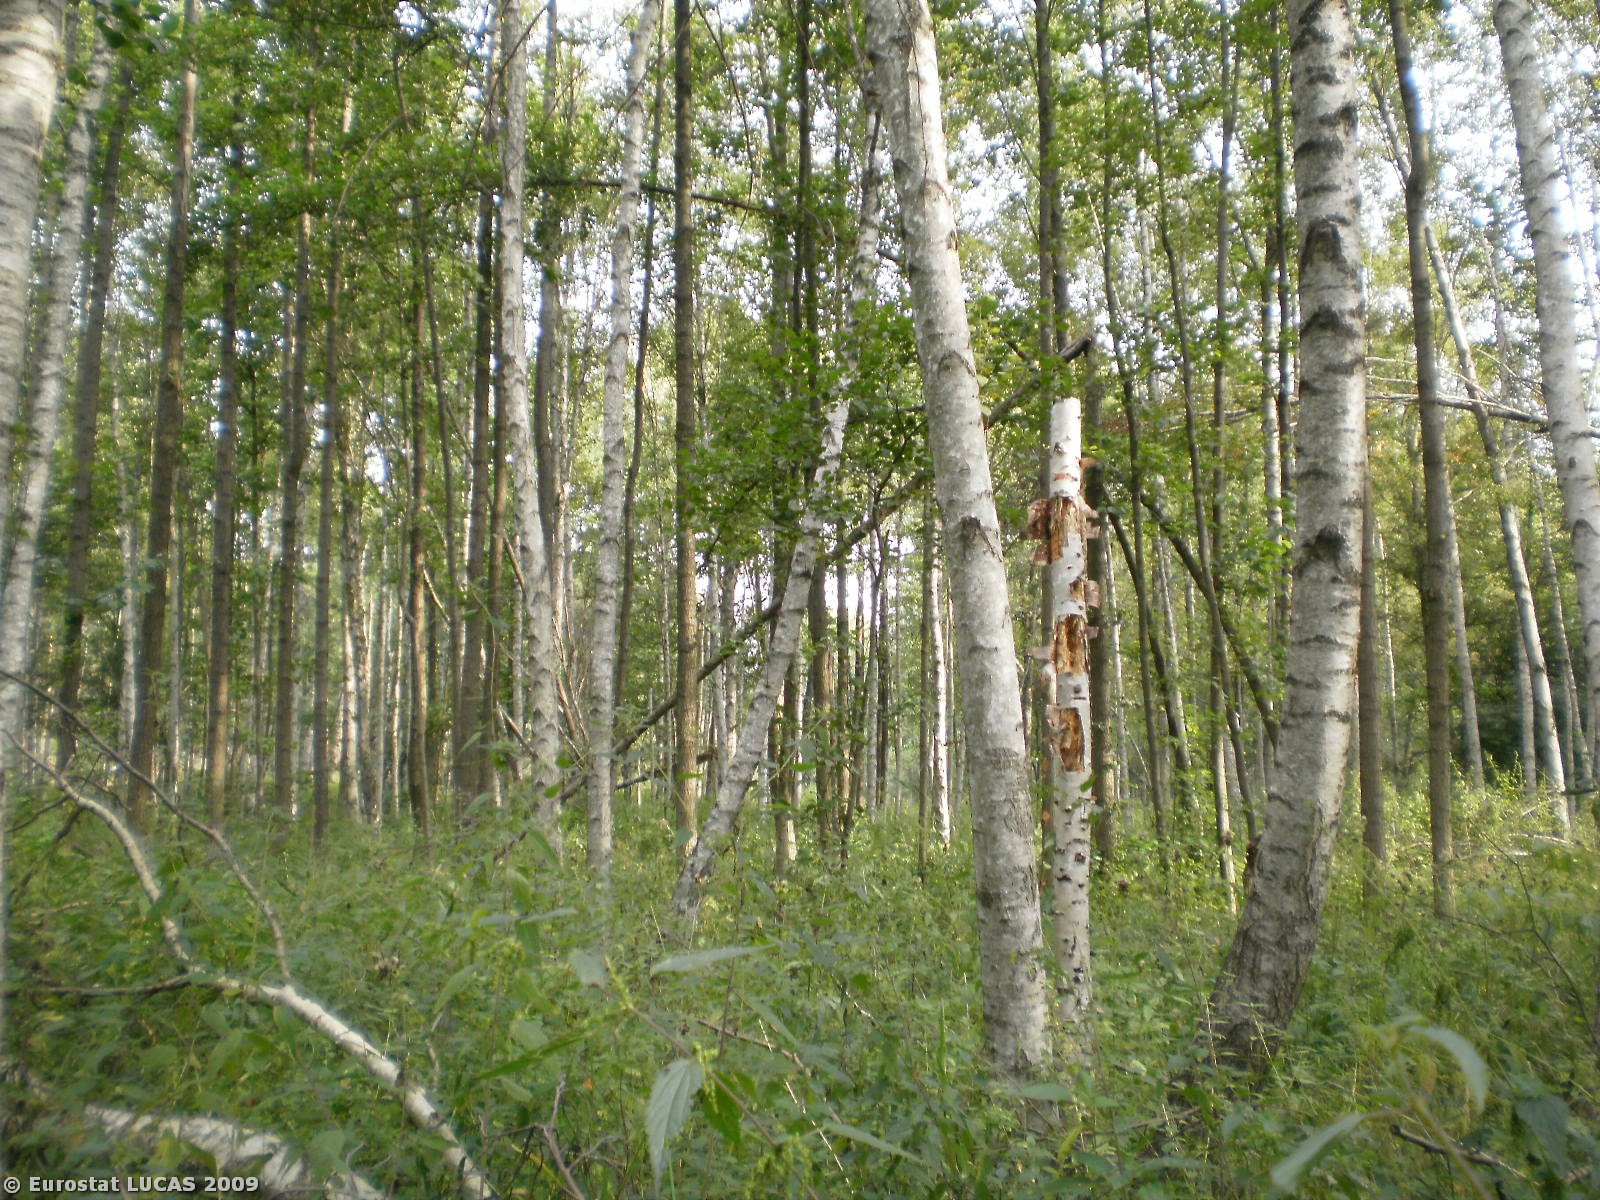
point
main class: Woodland
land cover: Broadleaved woodland
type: mesophytic deciduous forest
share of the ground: 50 - 75 %
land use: Forestry
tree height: > 5 m
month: September
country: PL
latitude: 53.7105
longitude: 21.6421
